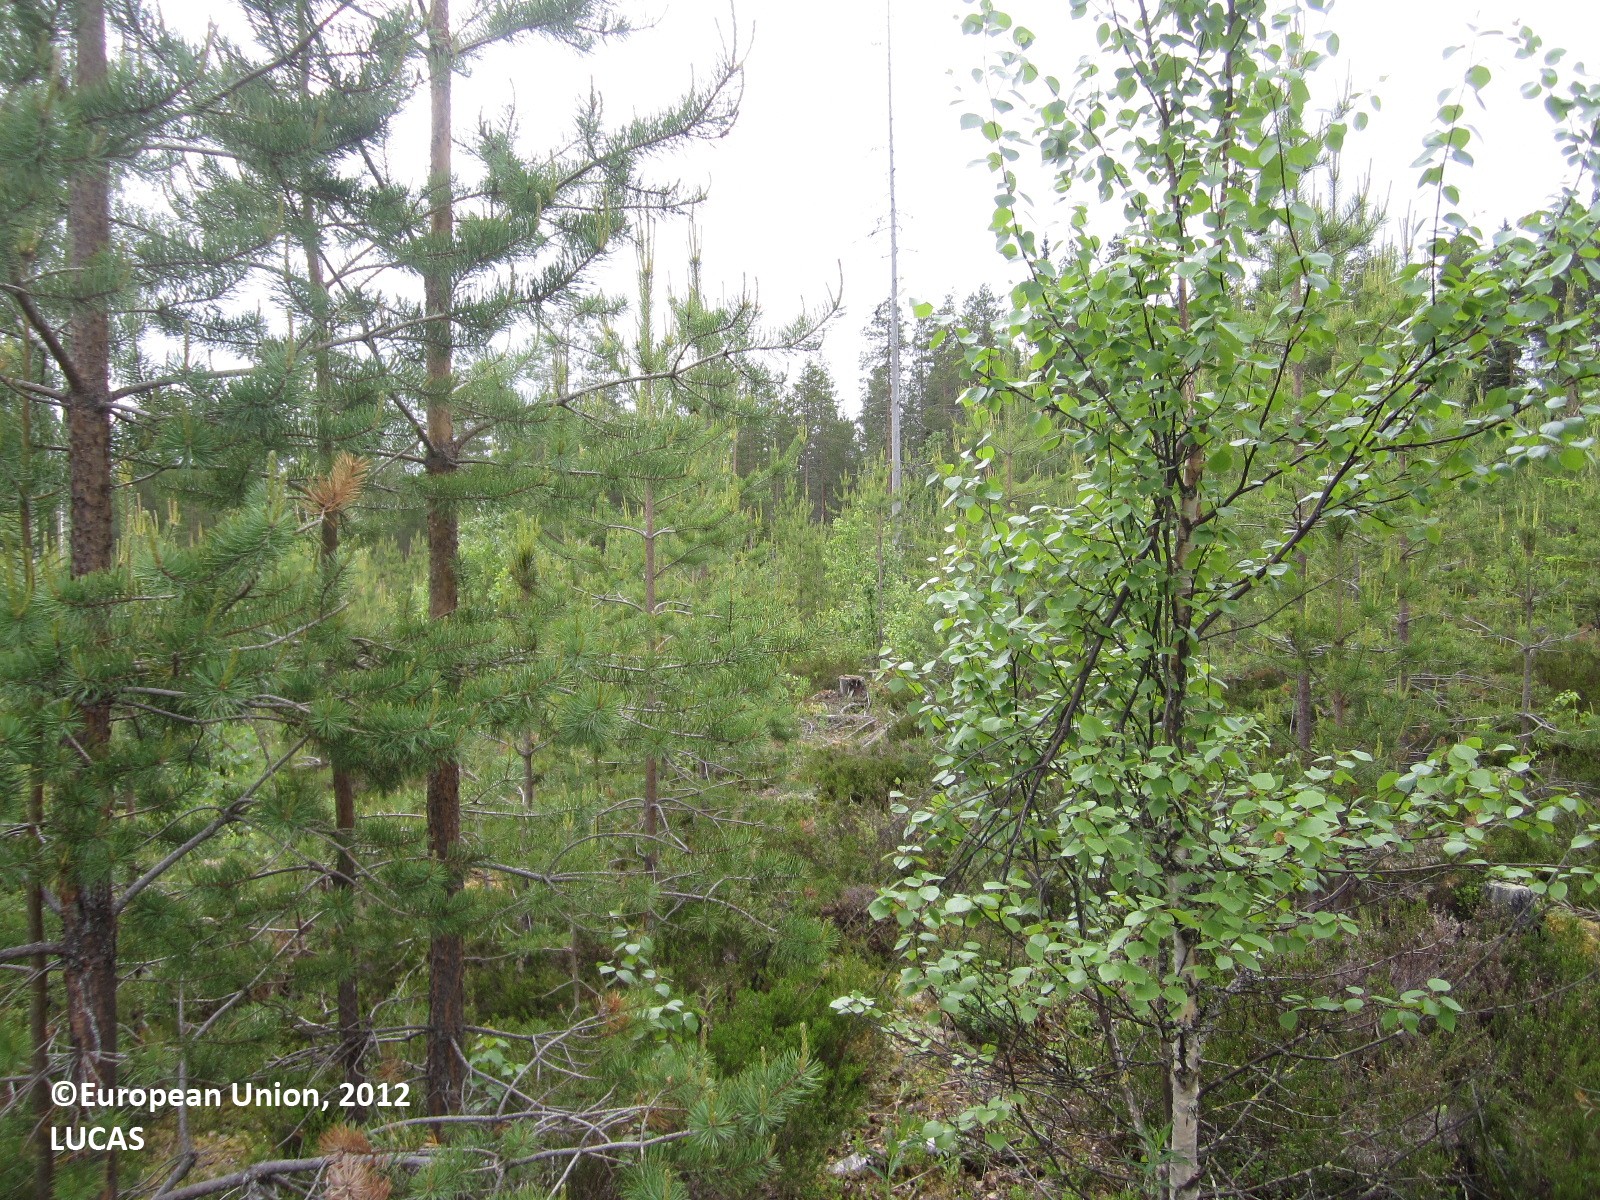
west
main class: Woodland
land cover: Pine dominated mixed woodland
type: boreal forest
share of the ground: 50 - 75 %
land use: Forestry
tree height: < 5 m
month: June
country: FI
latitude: 64.3570
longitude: 29.5830
